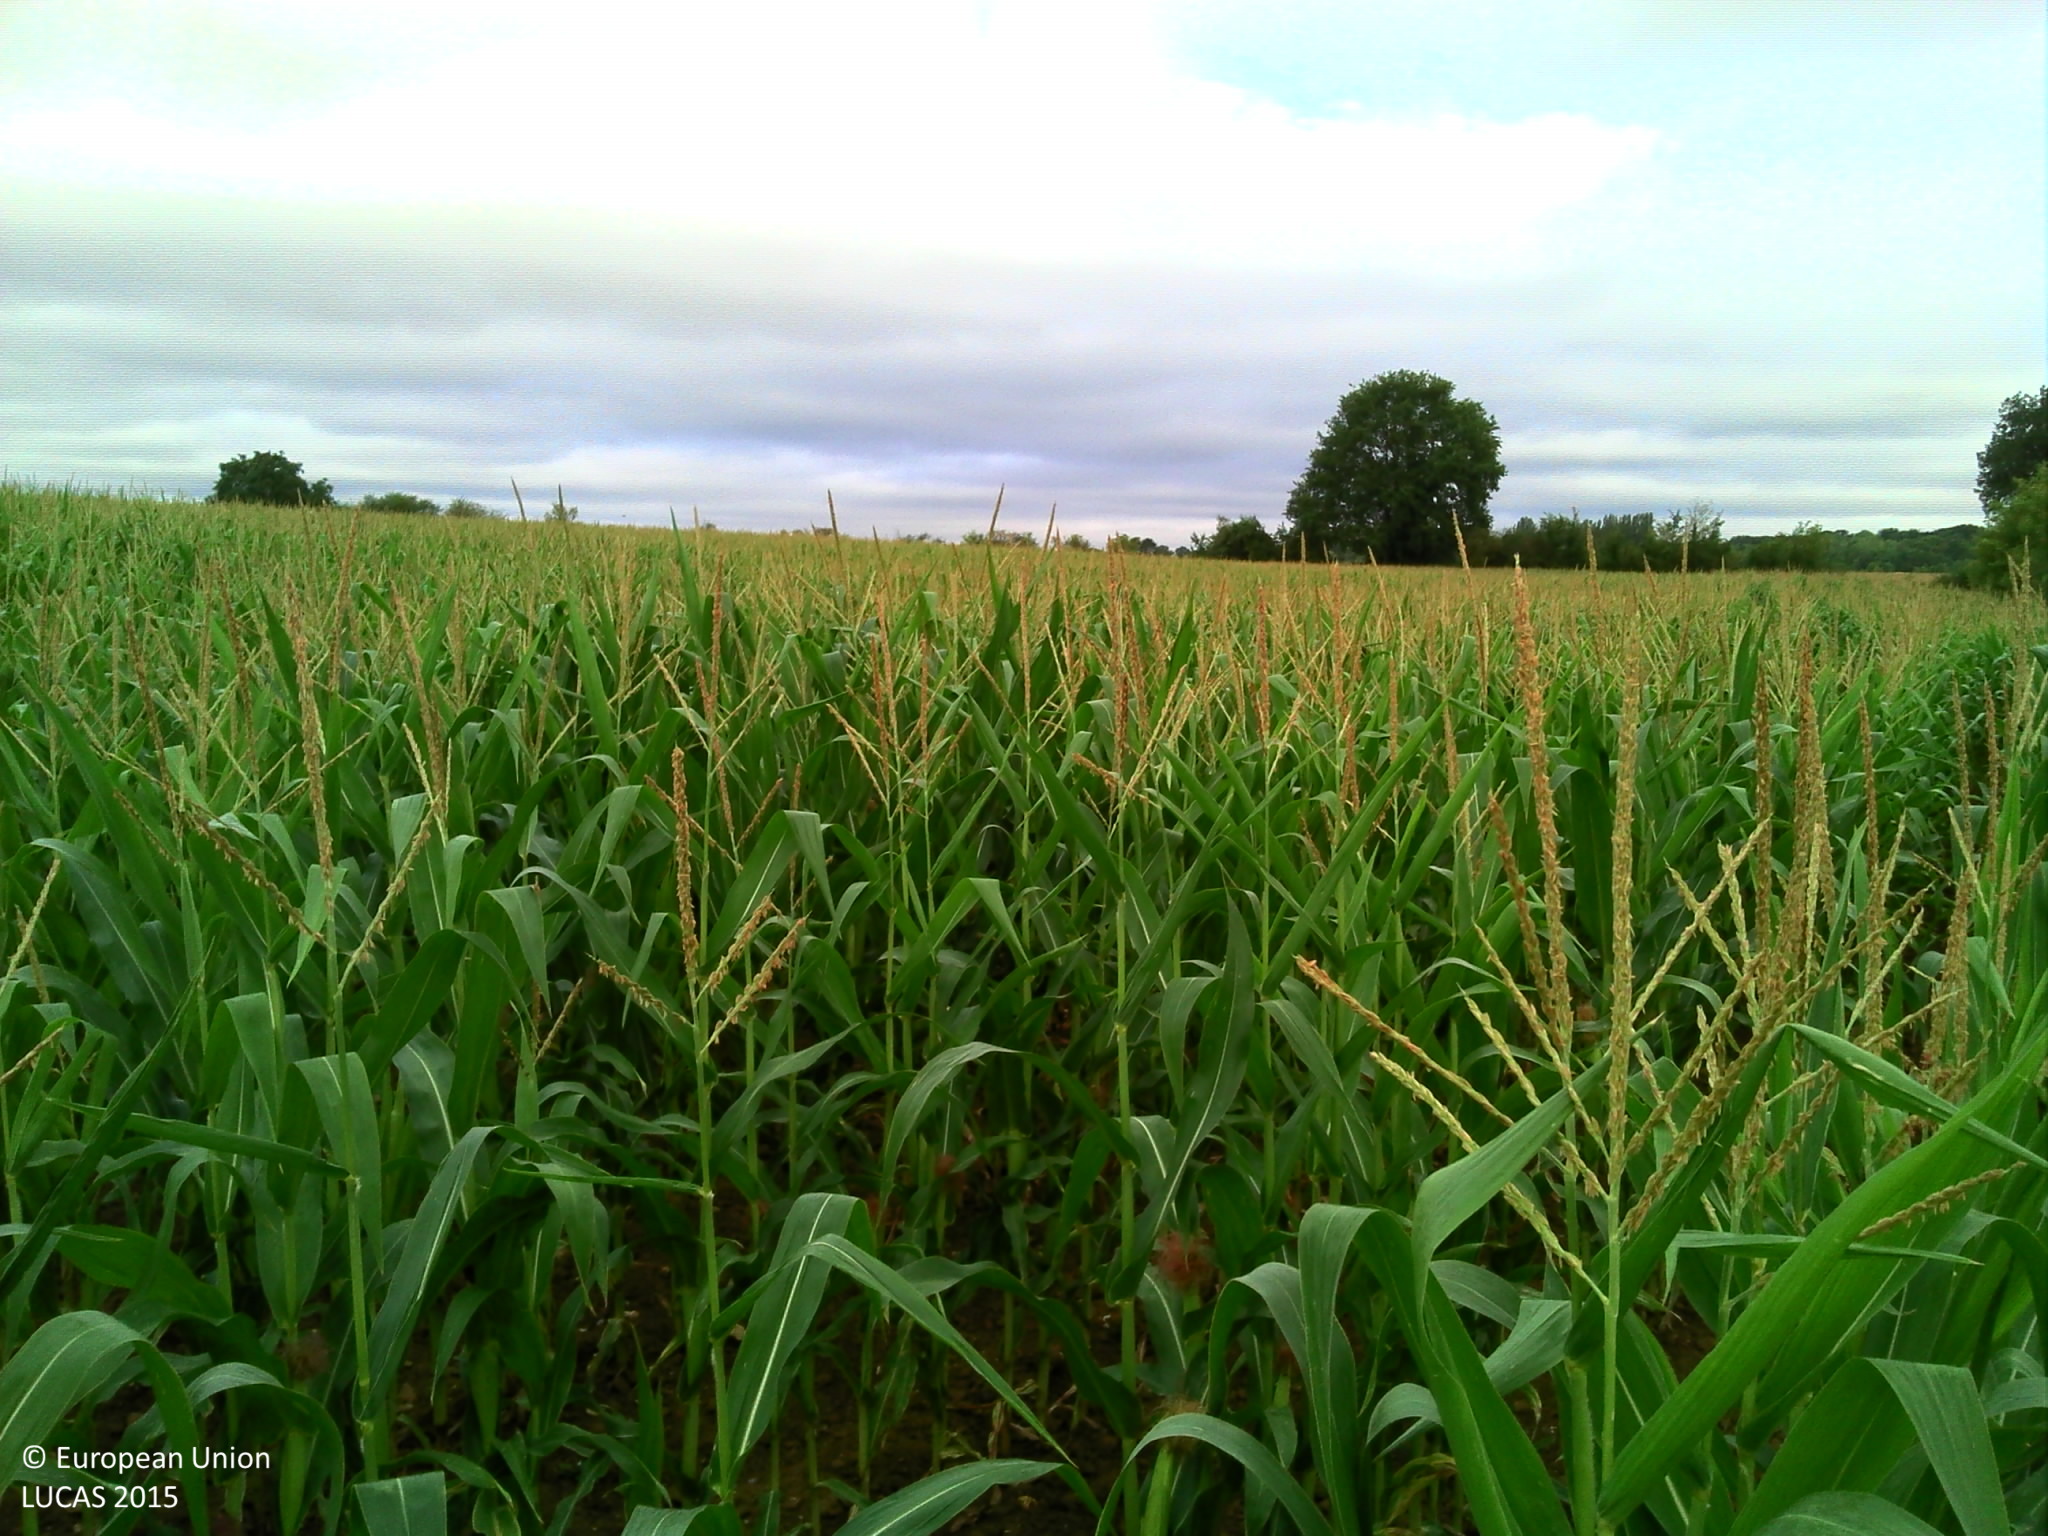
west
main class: Cropland
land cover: Maize
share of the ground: > 75 %
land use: Agriculture (excluding fallow land and kitchen gardens)
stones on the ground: < 10 %
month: July
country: FR
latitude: 49.2204
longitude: 2.5885
